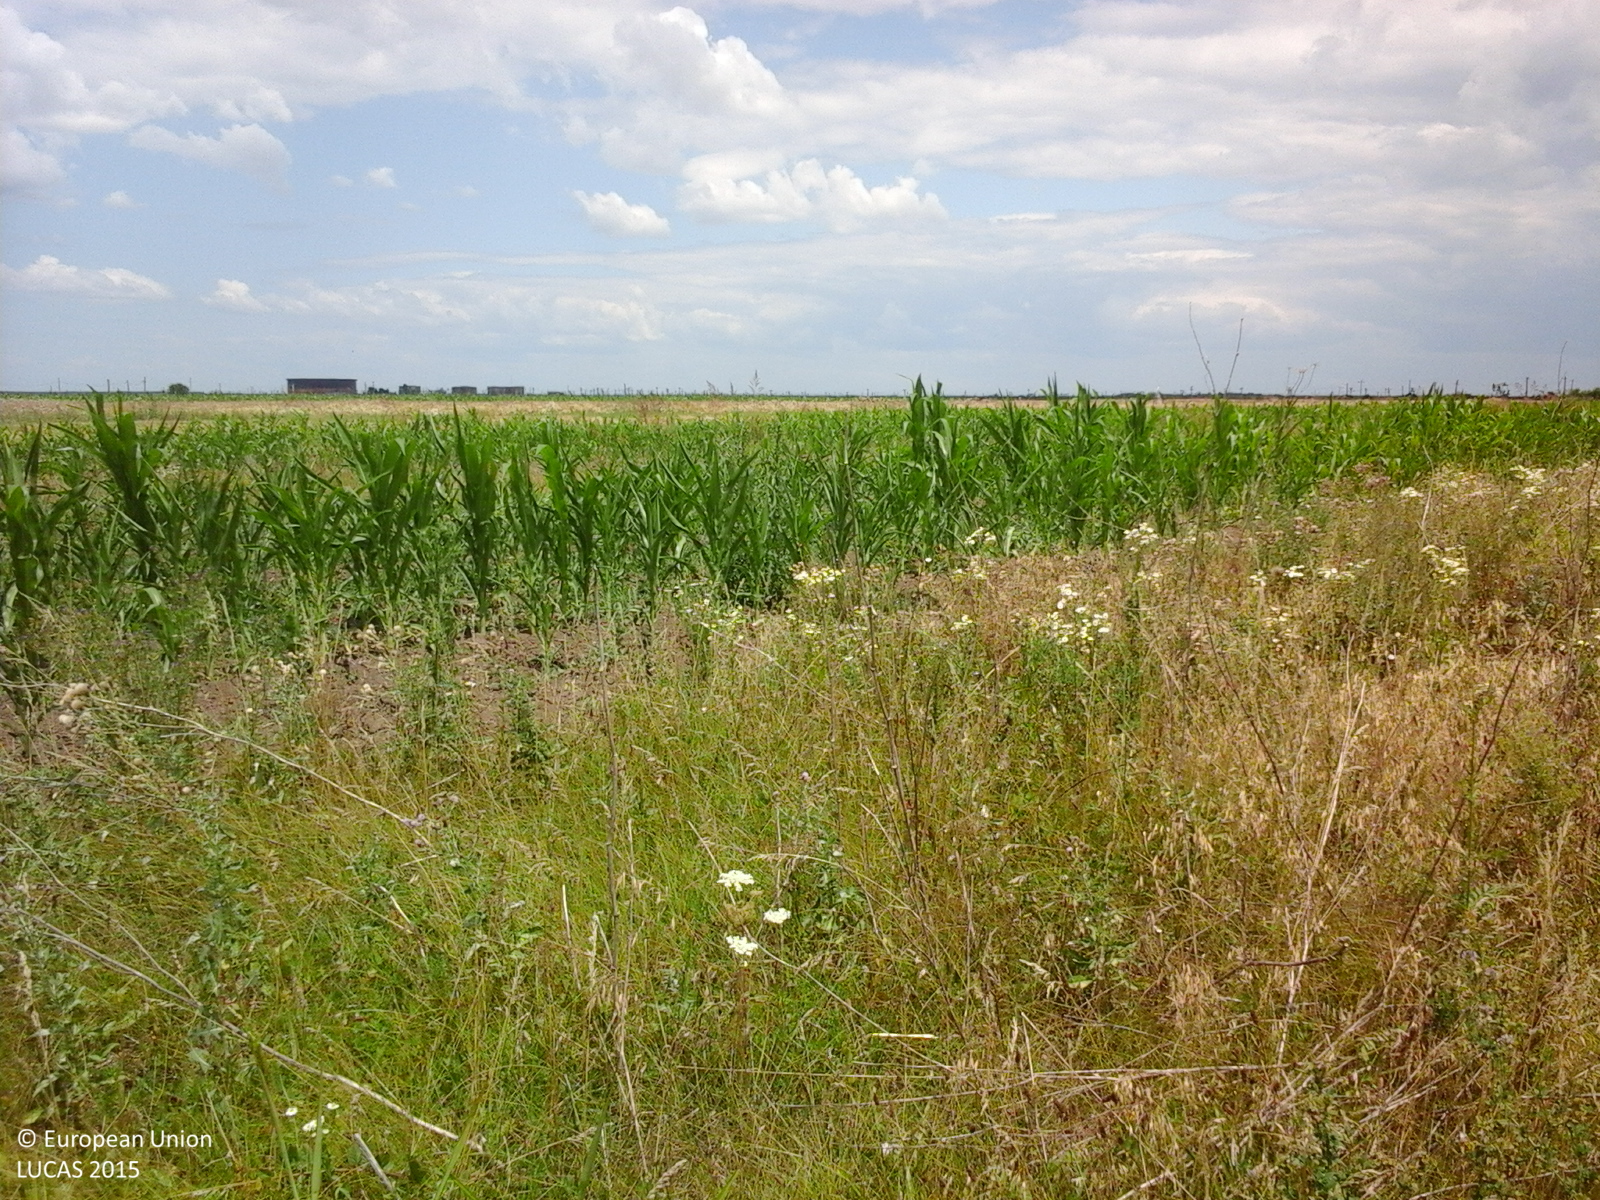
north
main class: Grassland
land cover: Spontaneously vegetated surfaces
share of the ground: > 75 %
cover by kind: herbaceous plants 100 %
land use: Fallow land
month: July
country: RO
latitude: 44.2906
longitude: 25.4148
